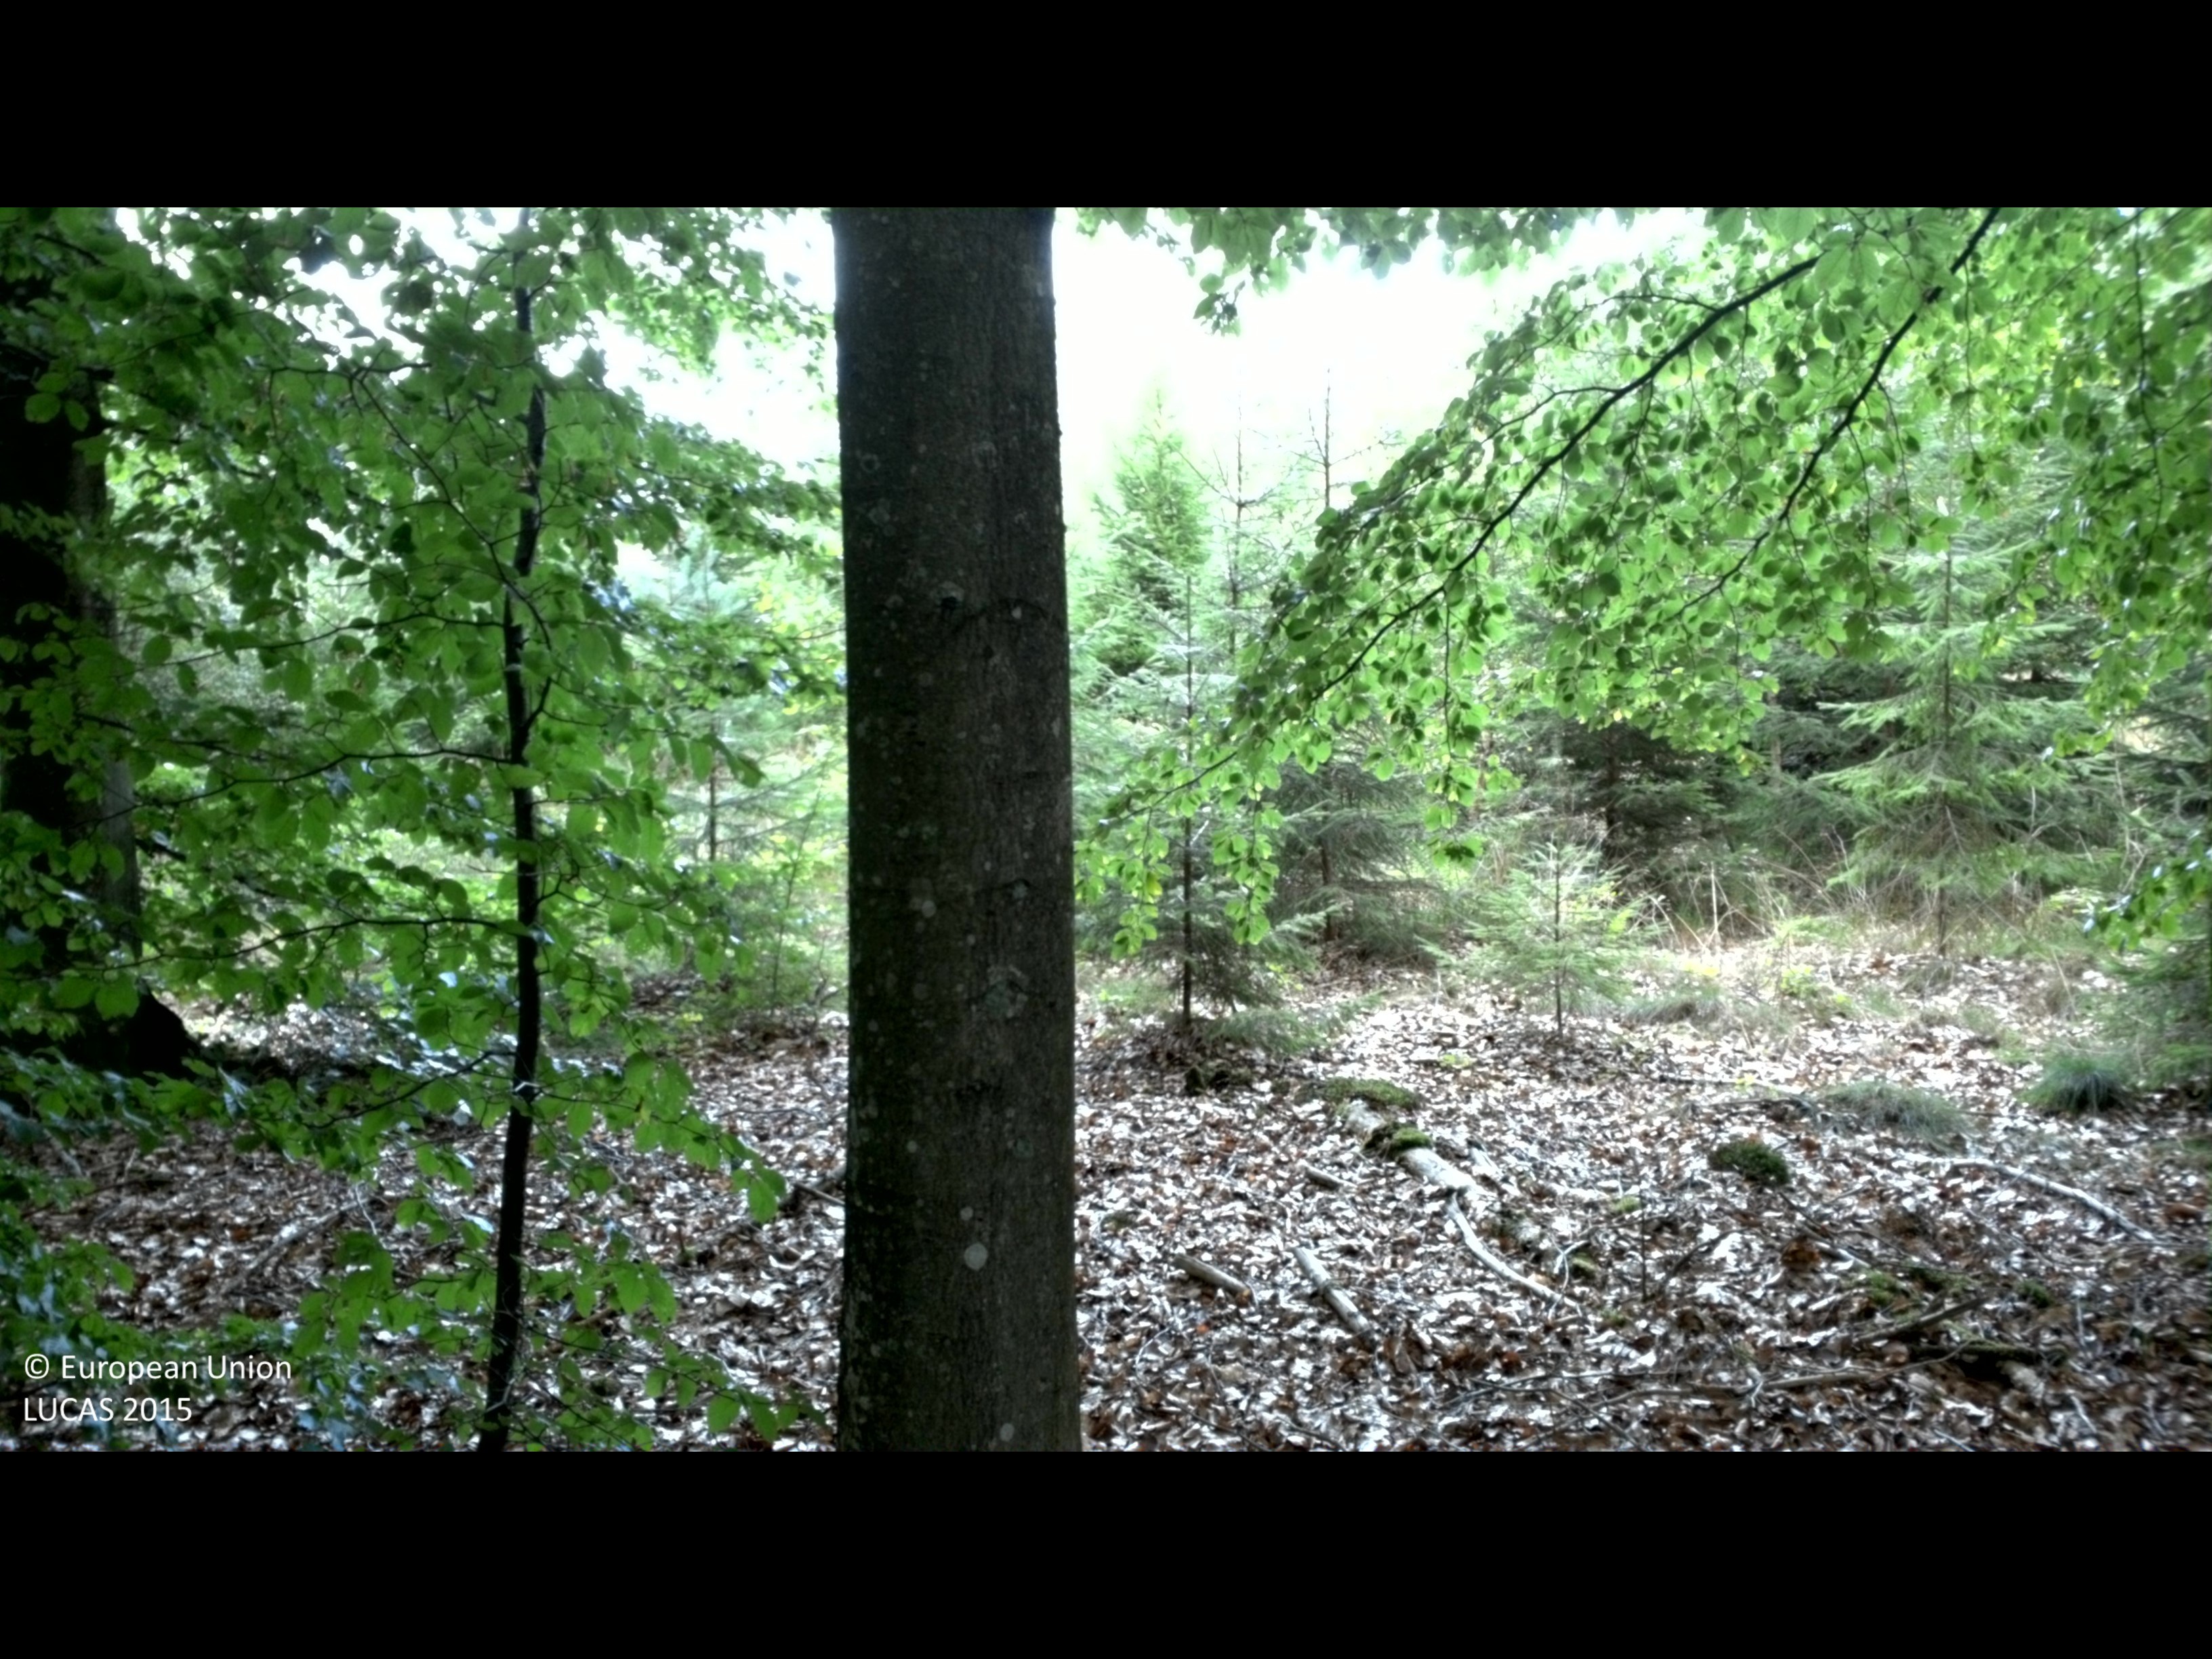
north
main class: Woodland
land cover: Broadleaved woodland
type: beech forest
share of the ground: > 75 %
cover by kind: broadleaved forest trees 85 %
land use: Forestry
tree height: > 5 m
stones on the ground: < 10 %
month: September
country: SE
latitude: 56.1498
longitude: 14.3602
